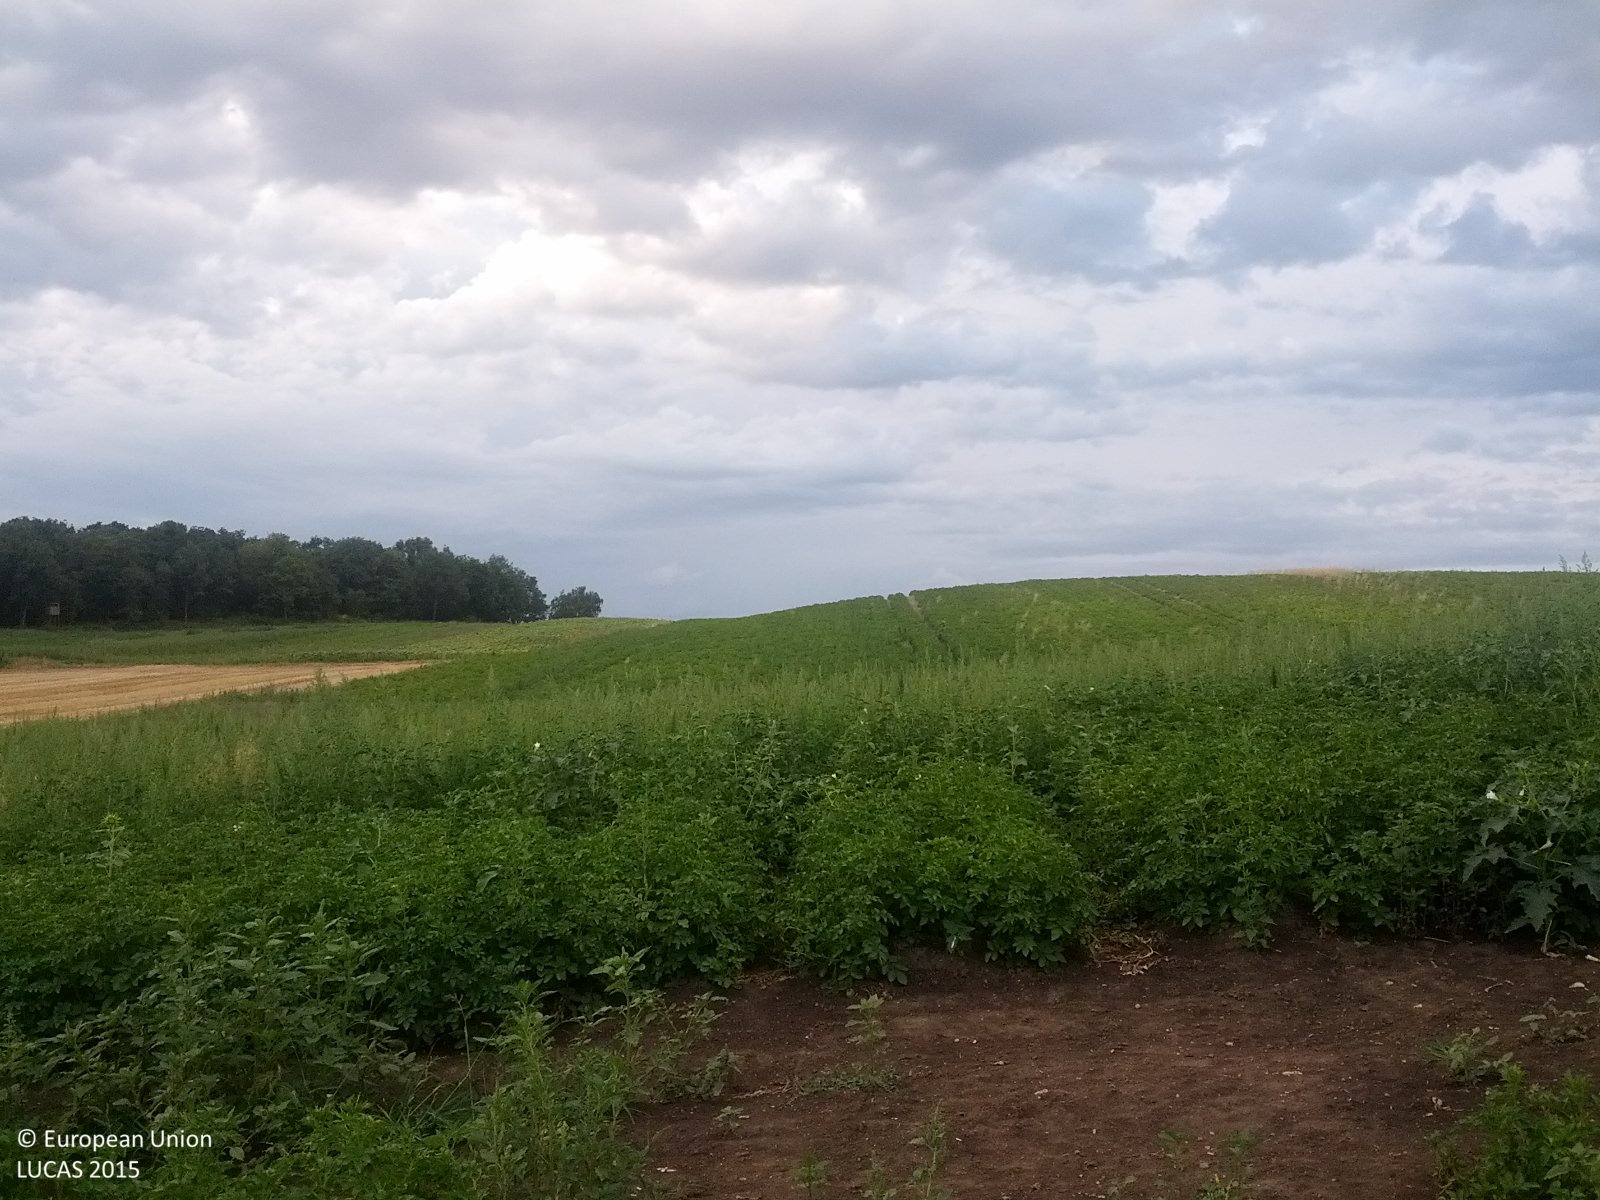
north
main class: Cropland
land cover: Potatoes
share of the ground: > 75 %
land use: Agriculture (excluding fallow land and kitchen gardens)
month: July
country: AT
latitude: 48.4931
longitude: 16.3247
